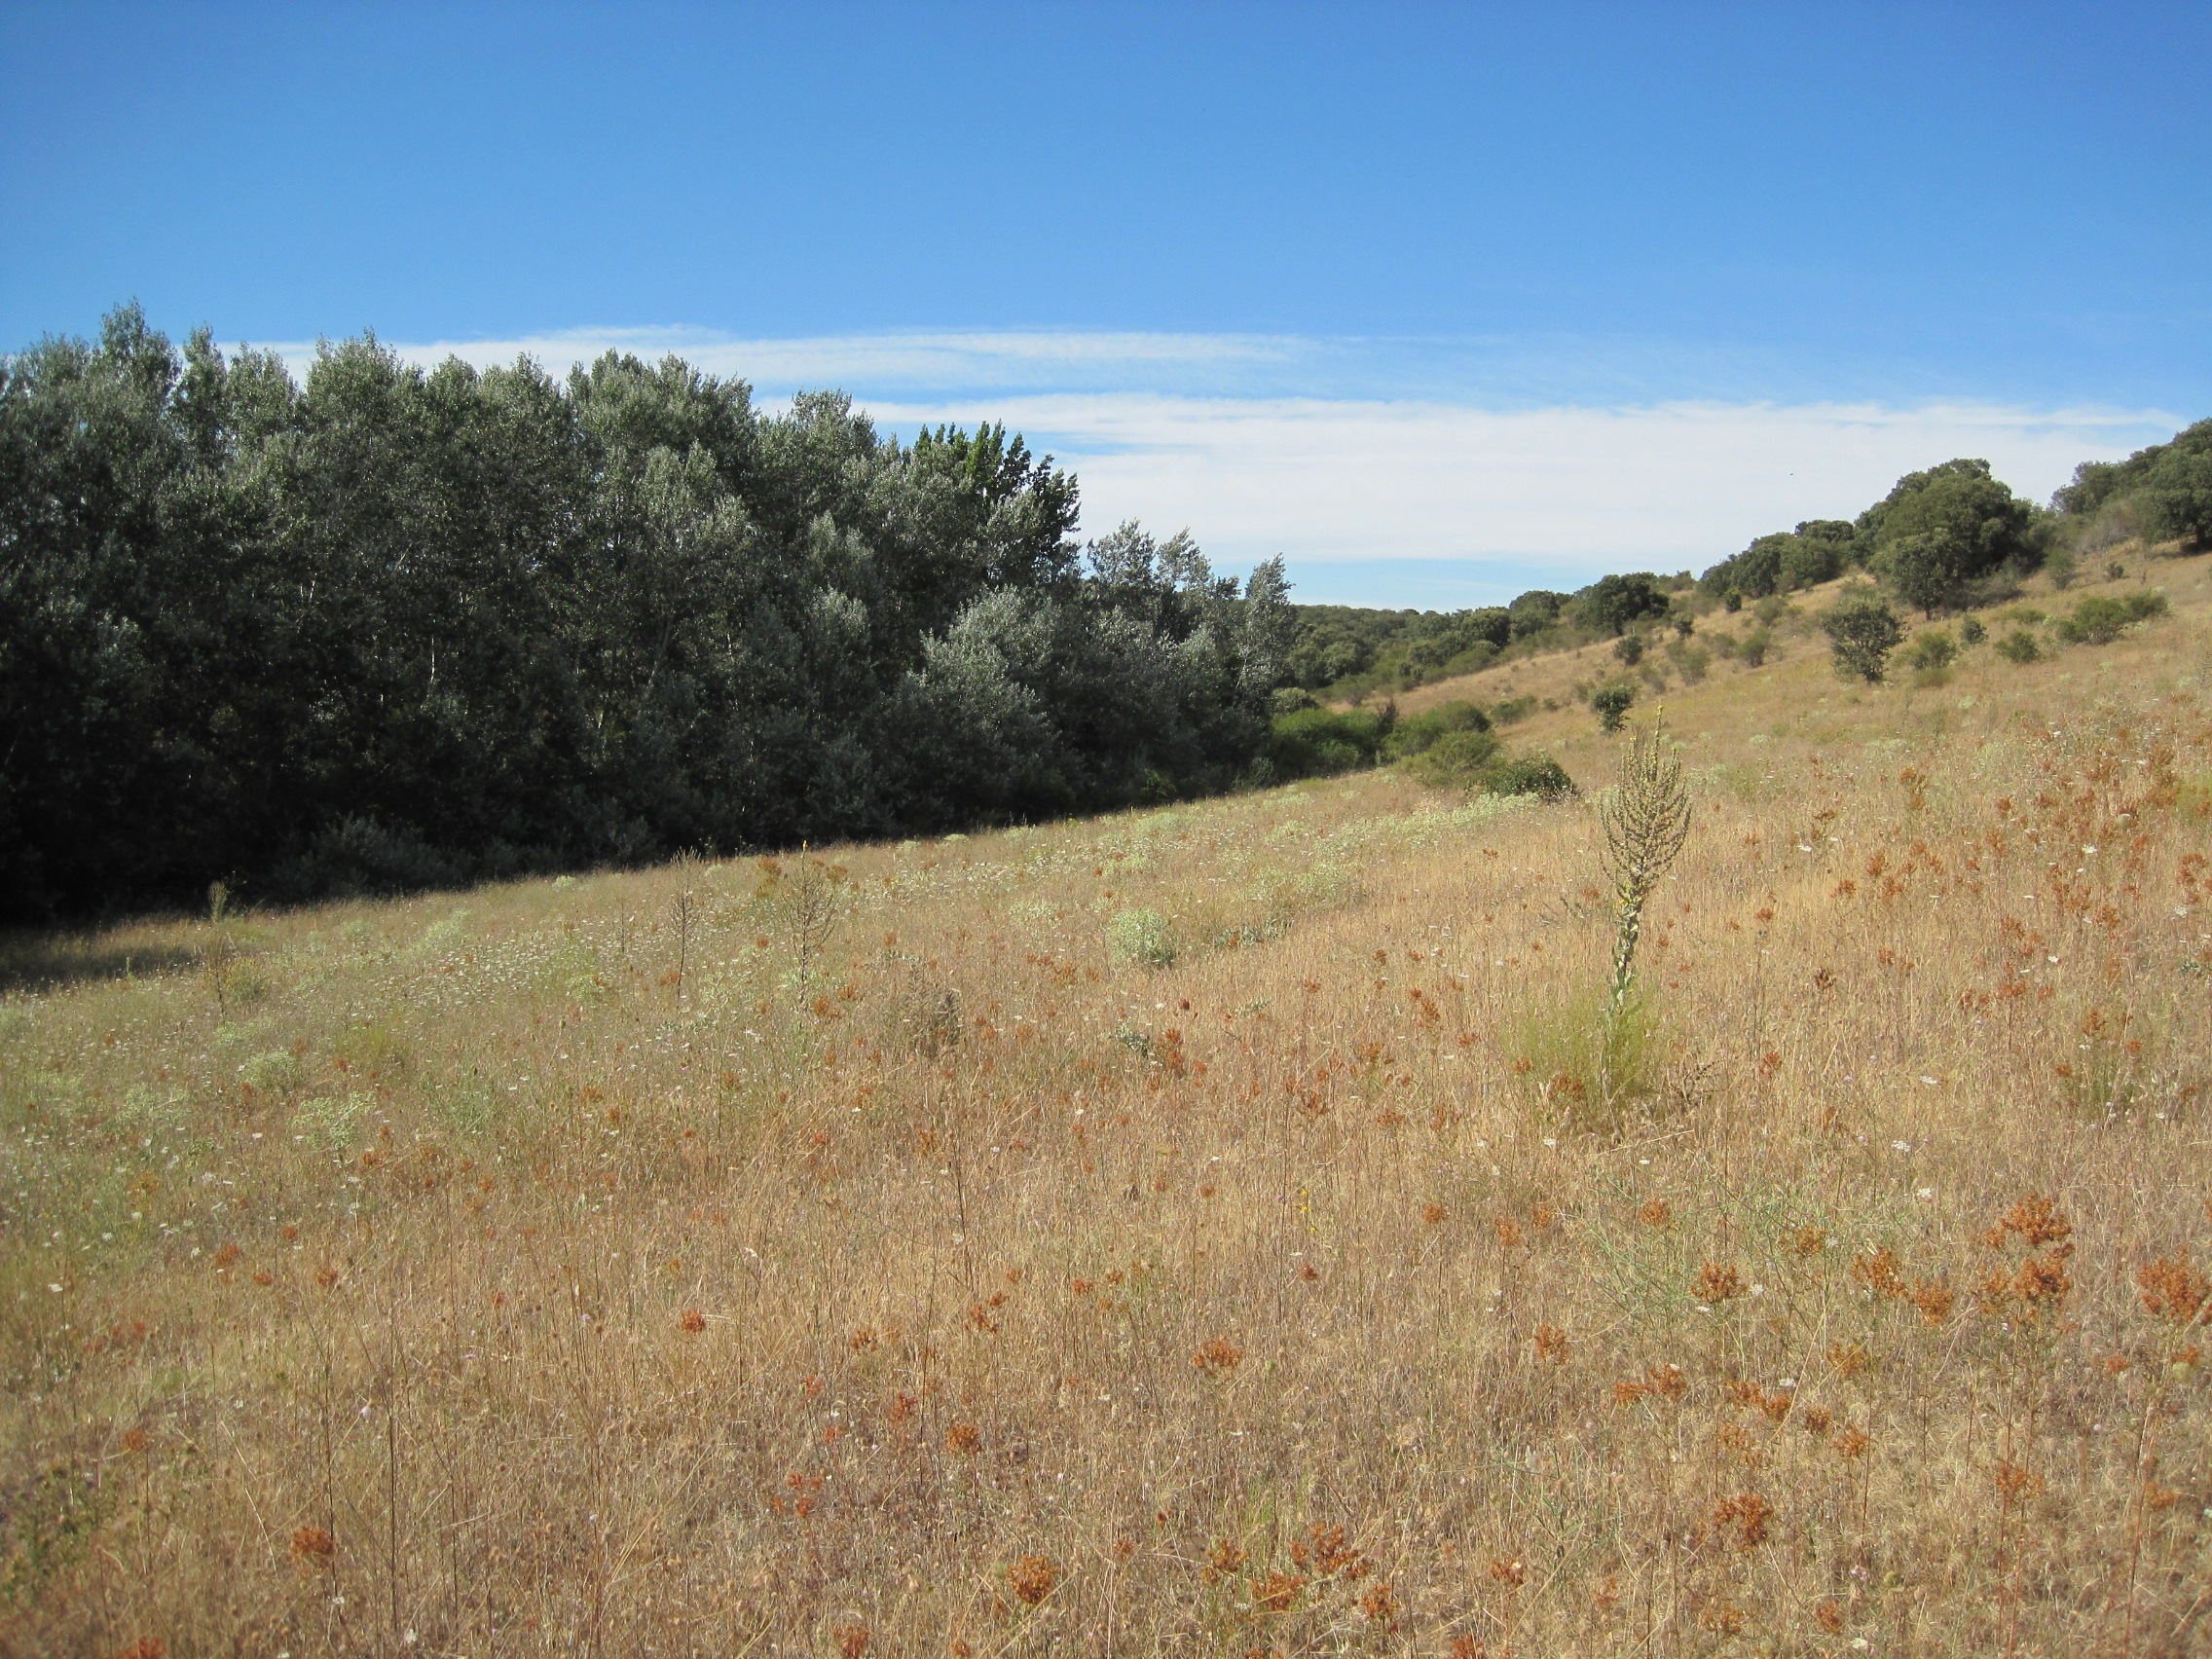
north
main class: Grassland
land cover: Grassland without tree/shrub cover
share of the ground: > 75 %
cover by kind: herbaceous plants 95 %, shrubs 5 %
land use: Semi-natural and natural areas not in use
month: July
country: ES
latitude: 42.0978
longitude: -5.4813
